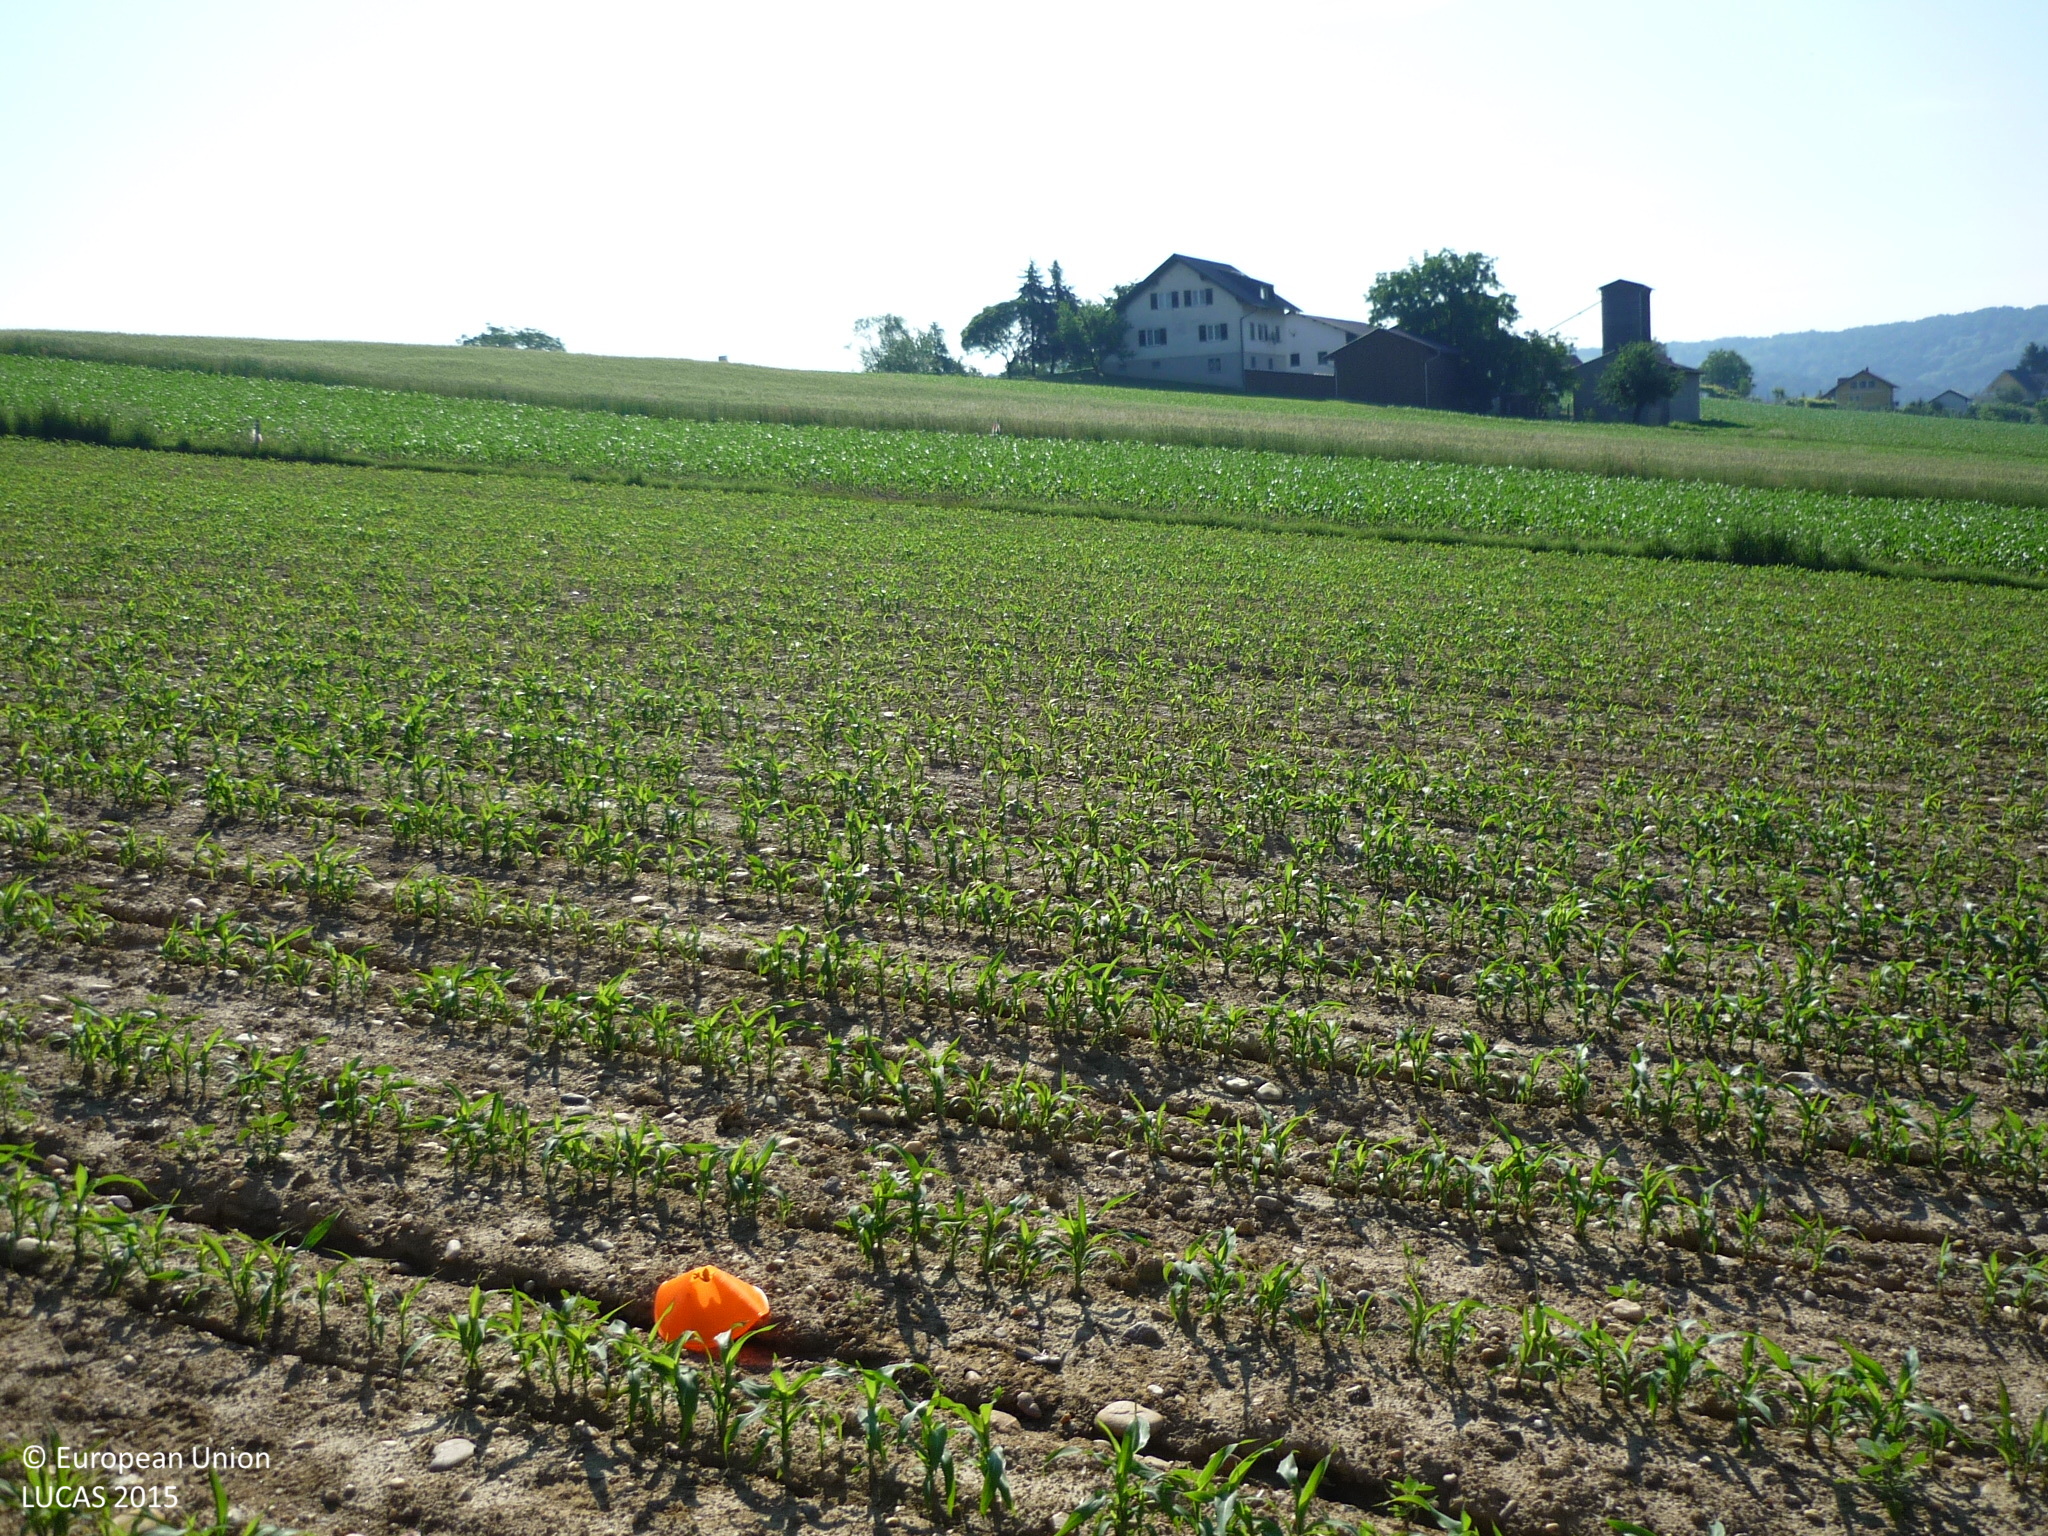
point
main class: Cropland
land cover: Maize
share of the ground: 25 - 50 %
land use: Agriculture (excluding fallow land and kitchen gardens)
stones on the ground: 10 - 25 %
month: June
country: AT
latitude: 46.8130
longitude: 15.7007
